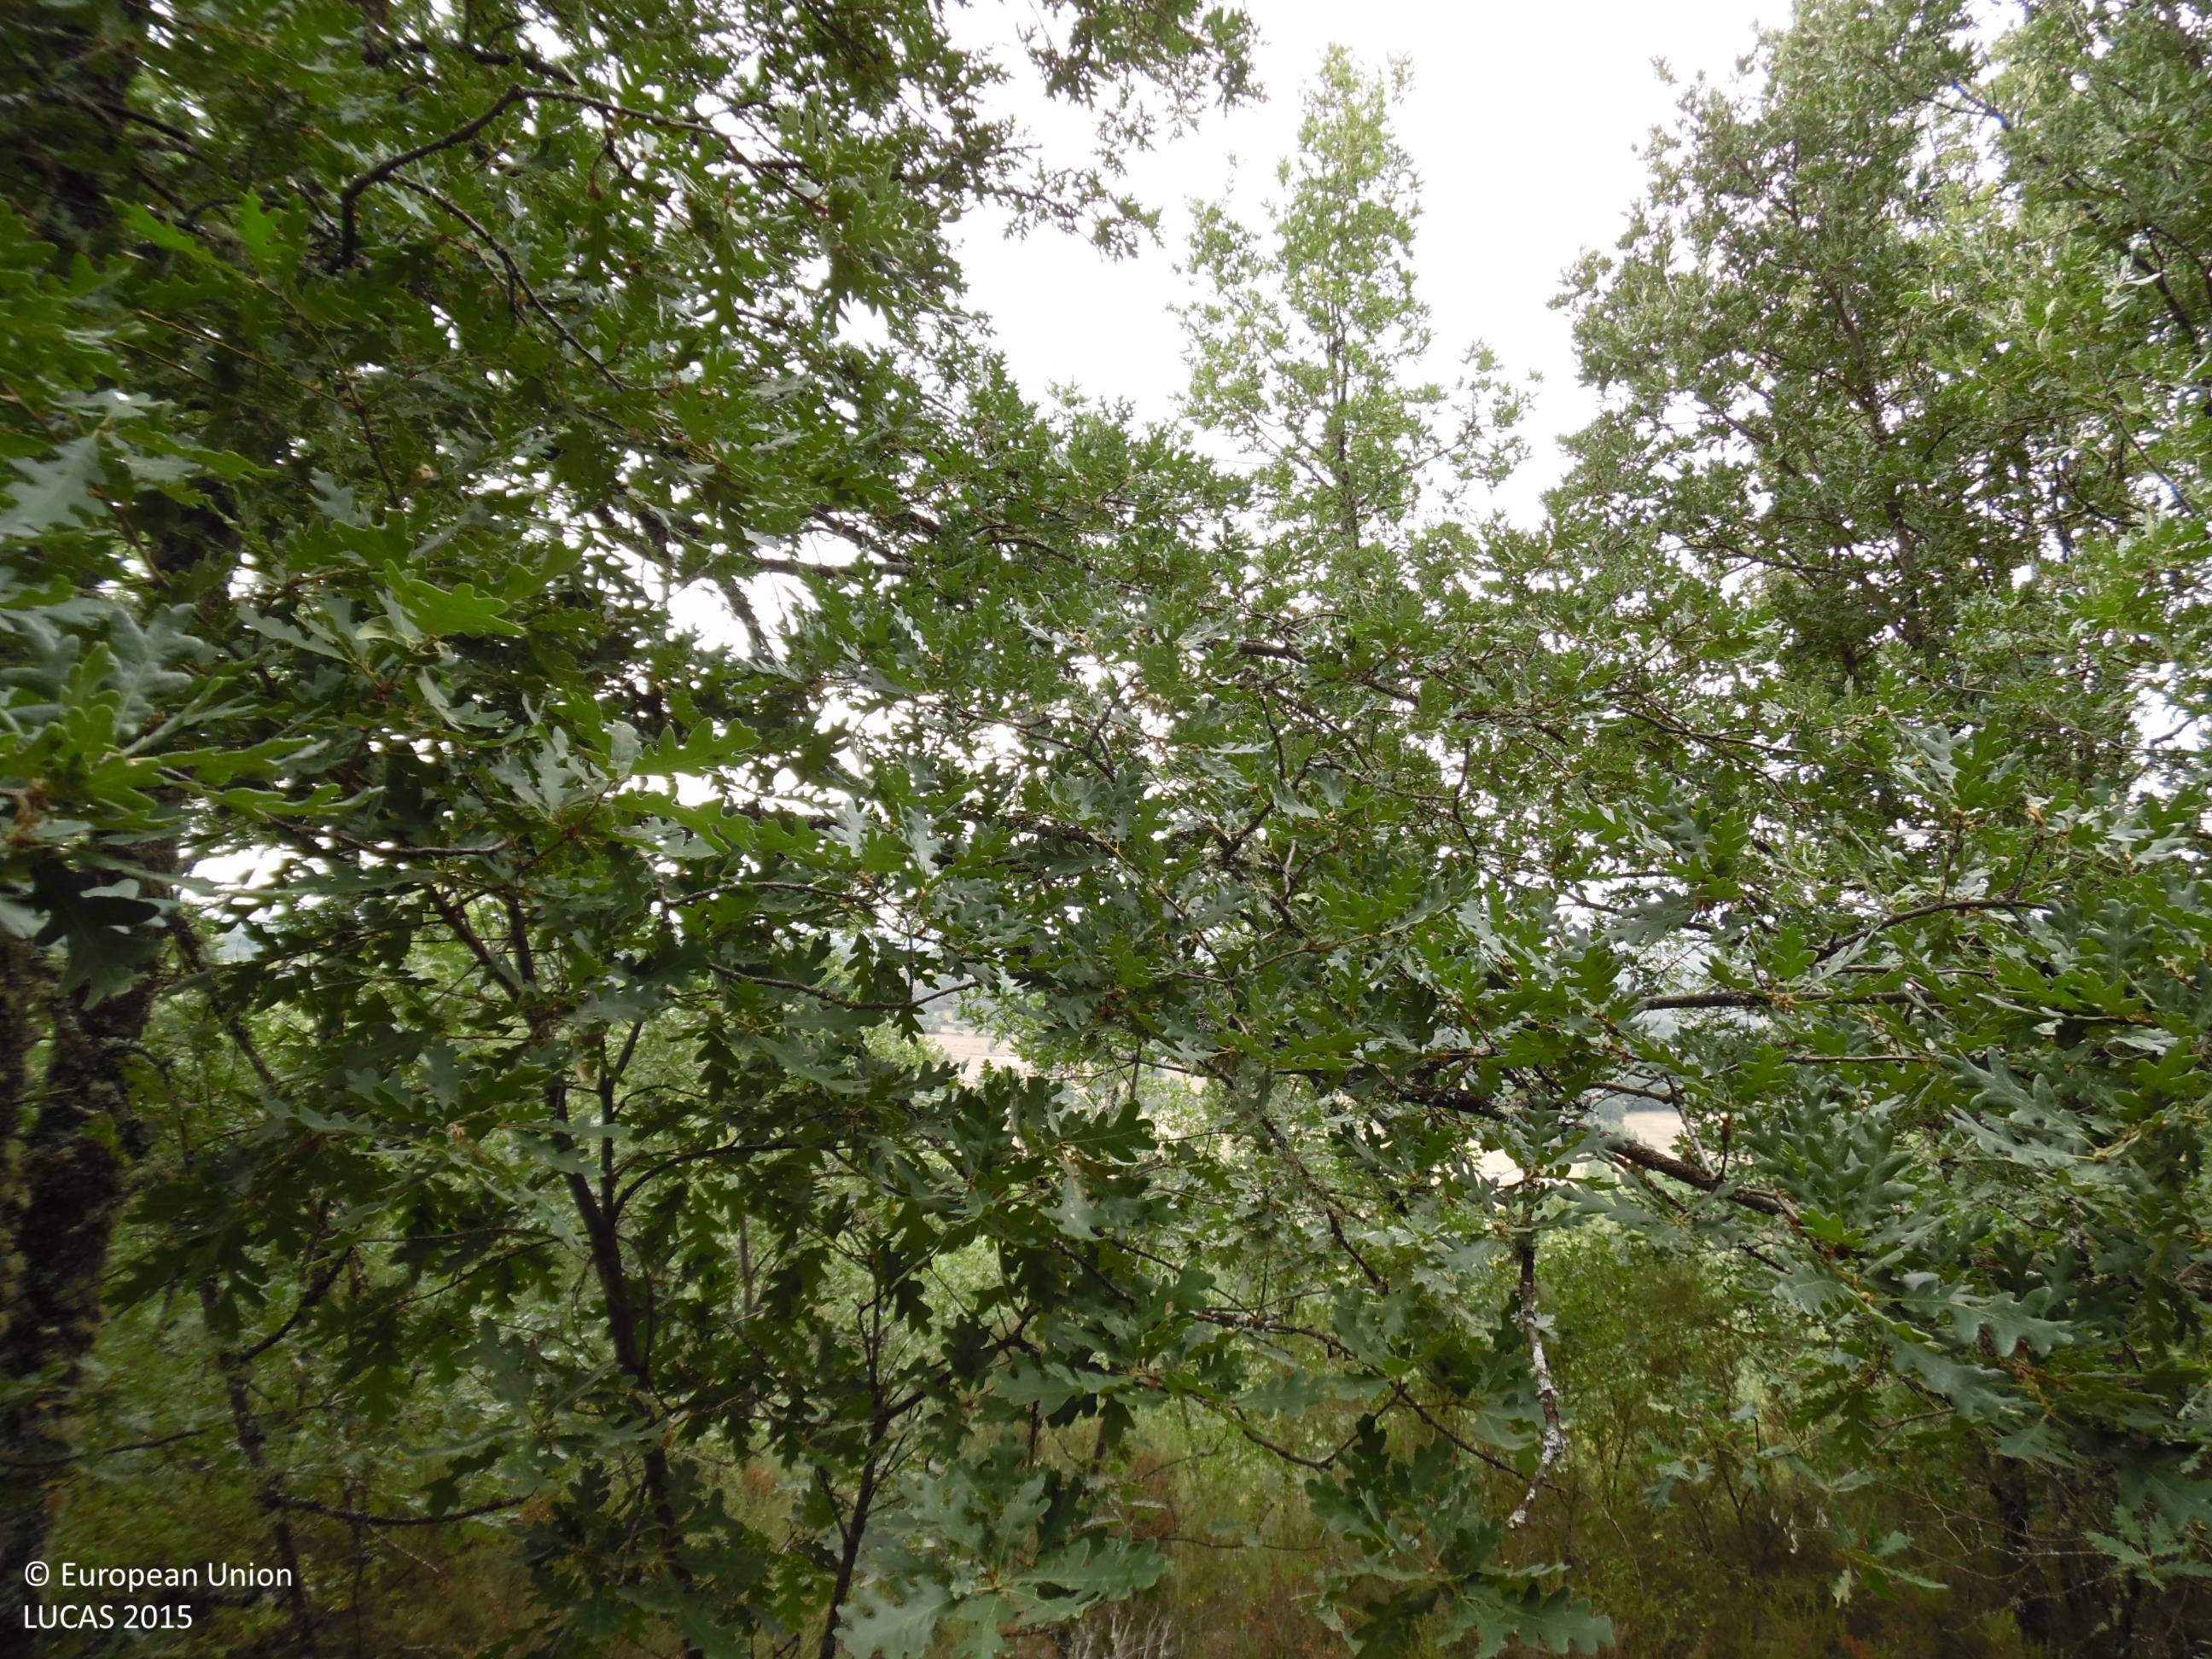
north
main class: Woodland
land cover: Broadleaved woodland
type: thermophilous deciduous forest
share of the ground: > 75 %
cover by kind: broadleaved forest trees 95 %, shrubs 5 %
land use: Forestry
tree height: > 5 m
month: July
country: ES
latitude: 42.7199
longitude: -5.8450
